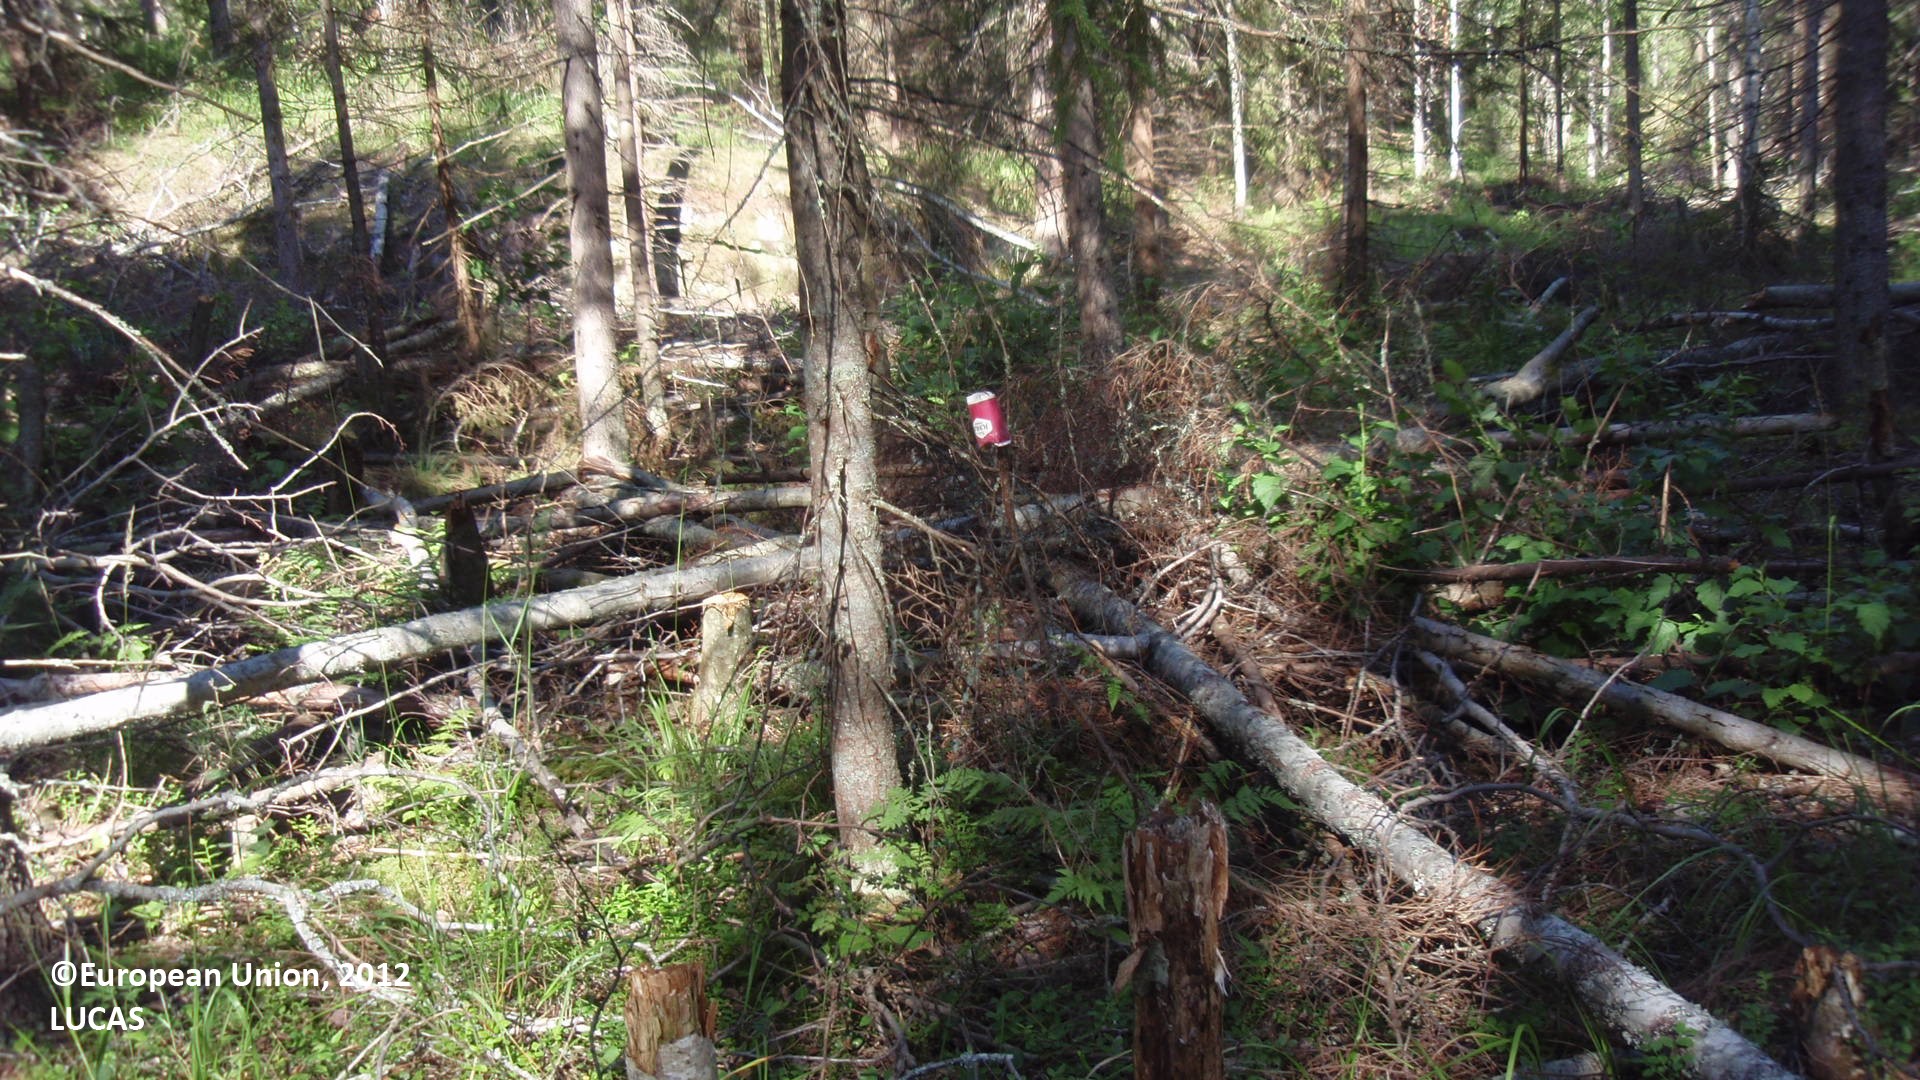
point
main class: Woodland
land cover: Spruce dominated mixed woodland
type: boreal forest
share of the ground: 25 - 50 %
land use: Forestry
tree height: > 5 m
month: July
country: FI
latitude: 61.1121
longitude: 28.2239
